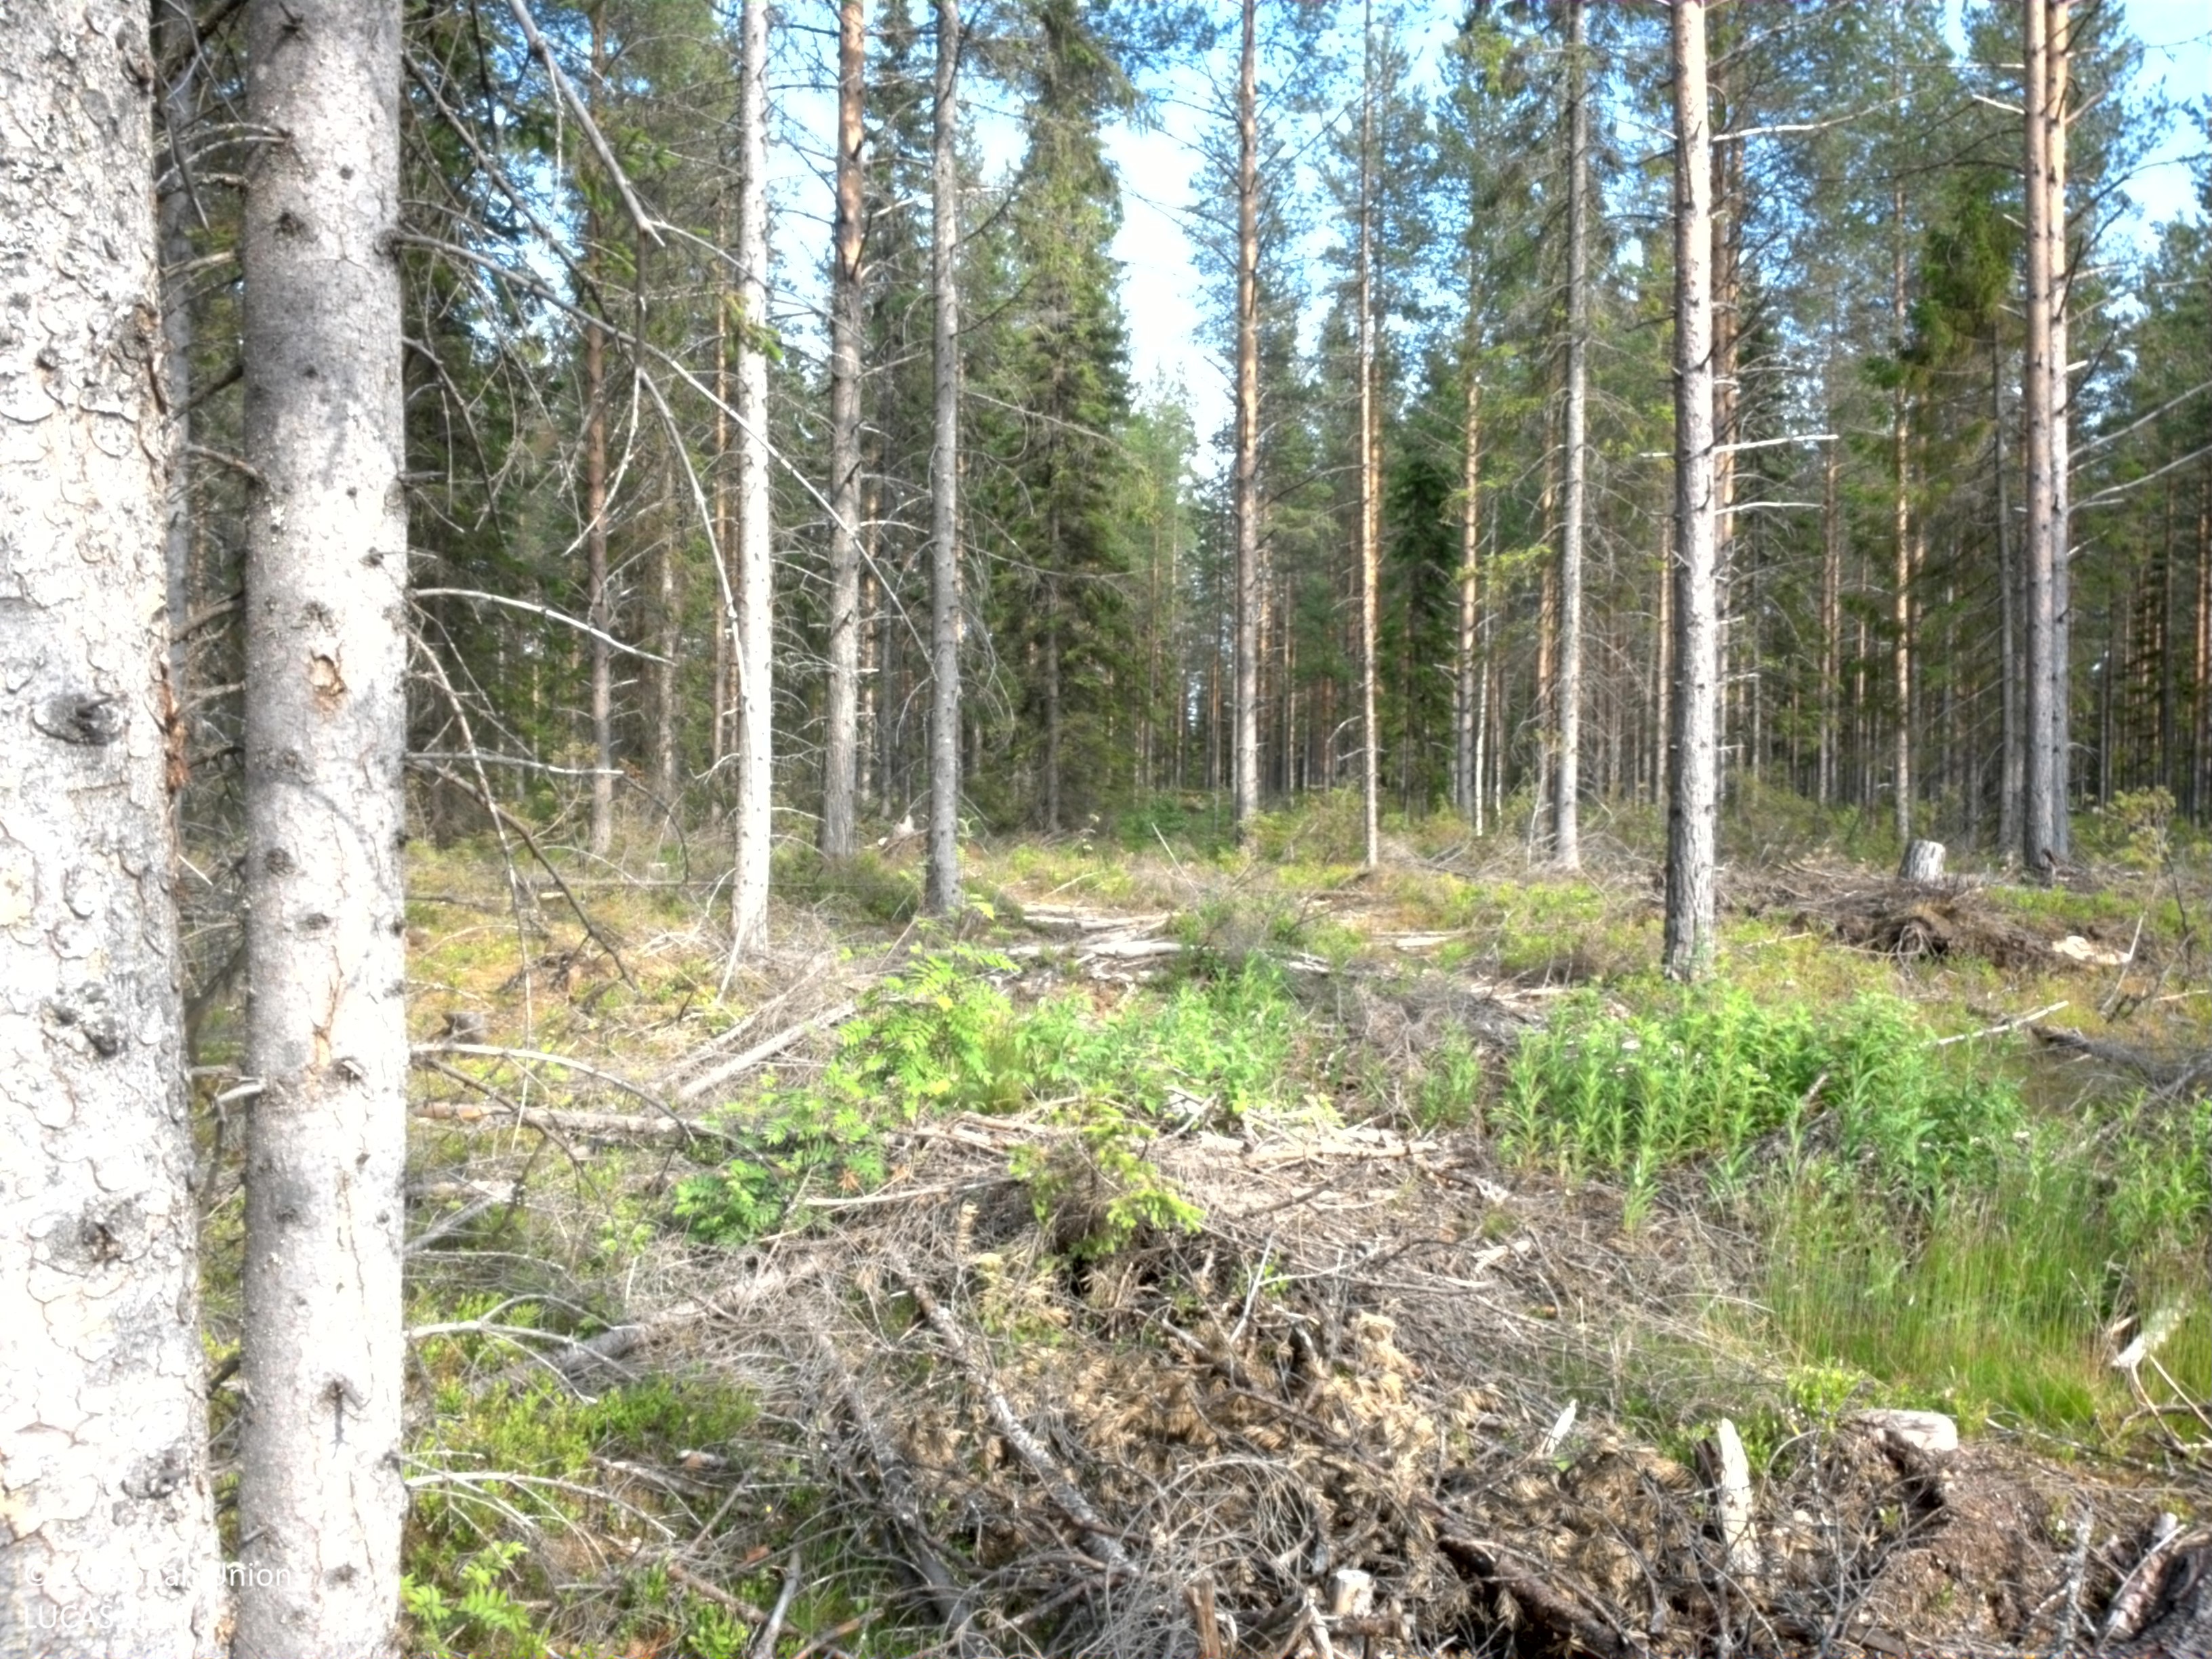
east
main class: Woodland
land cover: Pine dominated coniferous woodland
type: boreal forest
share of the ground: 50 - 75 %
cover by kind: coniferous forest trees 75 %, shrubs 20 %, herbaceous plants 5 %
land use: Forestry
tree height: > 5 m
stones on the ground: > 50 %
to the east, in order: Pine dominated coniferous woodland; Spruce dominated mixed woodland; Other mixed woodland
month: July
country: SE
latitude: 64.4662
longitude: 20.8128
